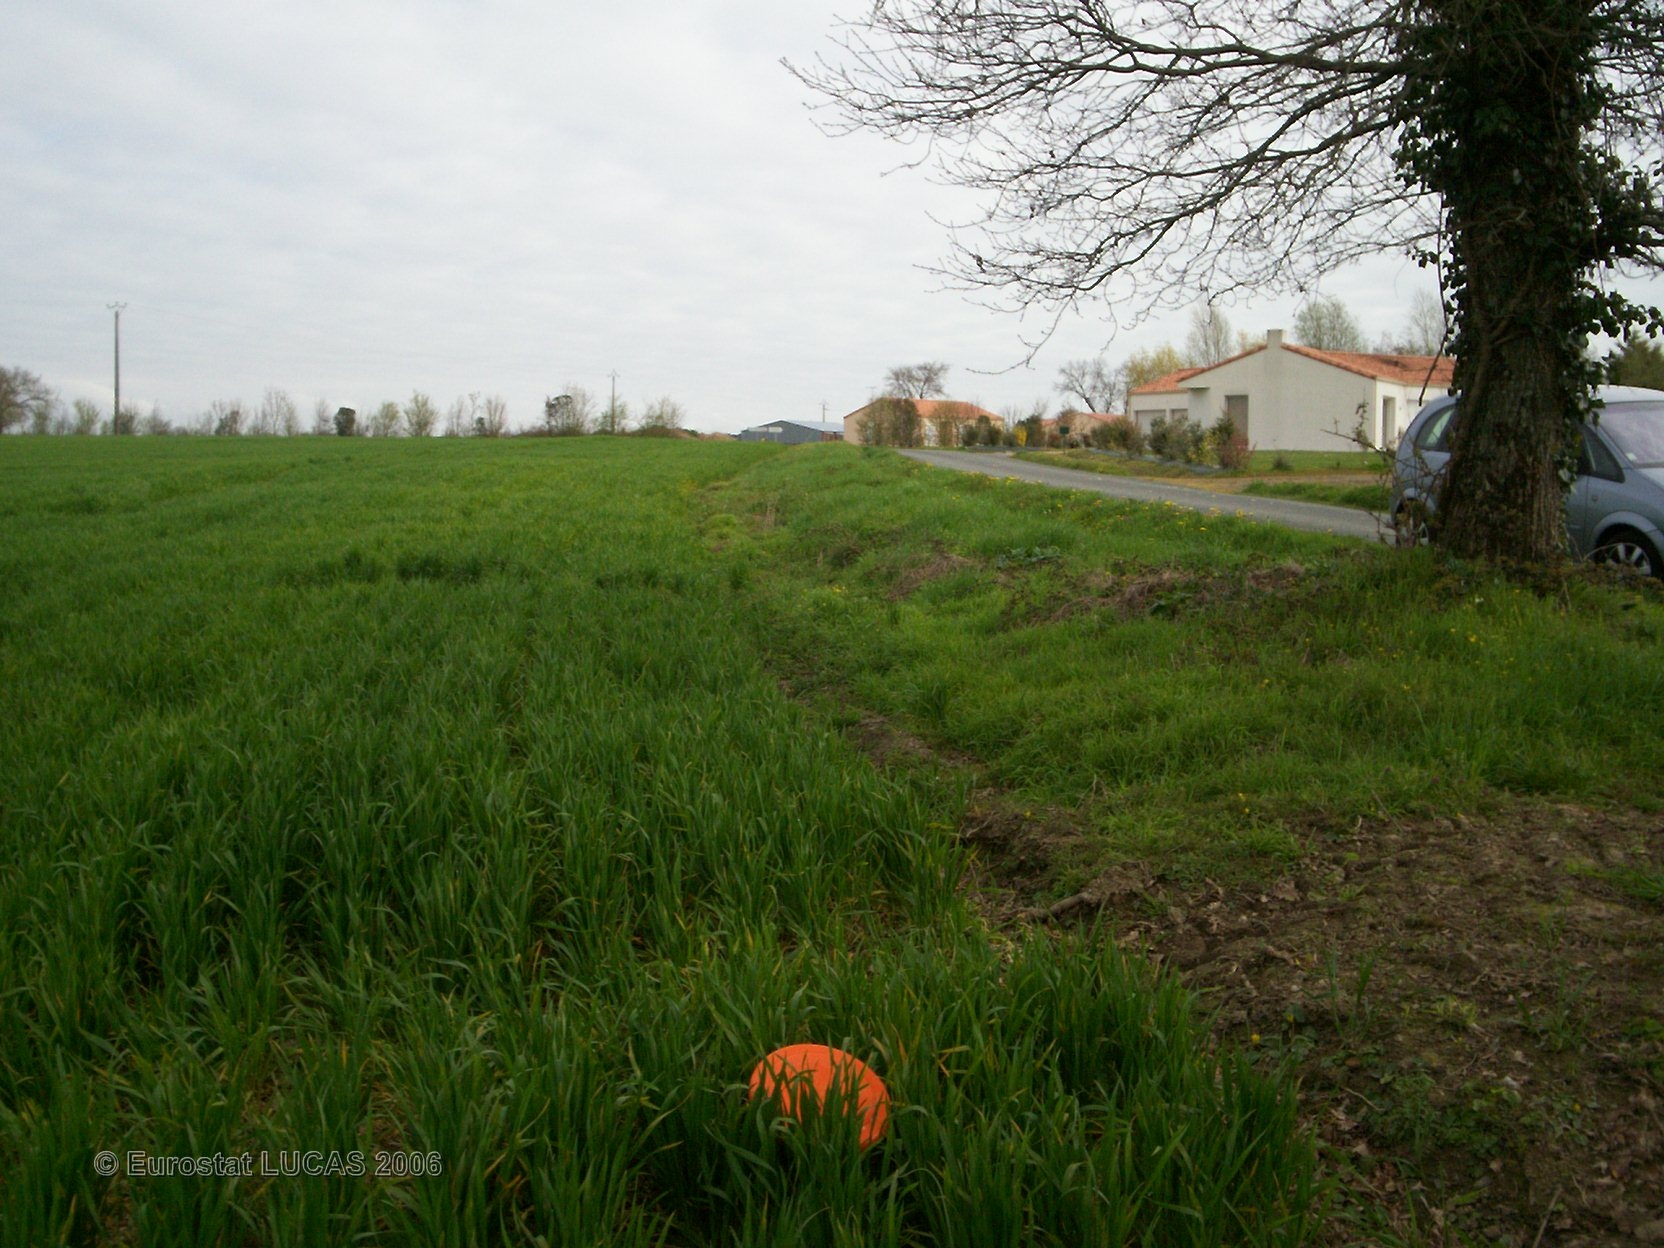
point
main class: Cropland
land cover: Common wheat
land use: Agriculture (excluding fallow land and kitchen gardens)
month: April
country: FR
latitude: 46.9092
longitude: -1.3420
